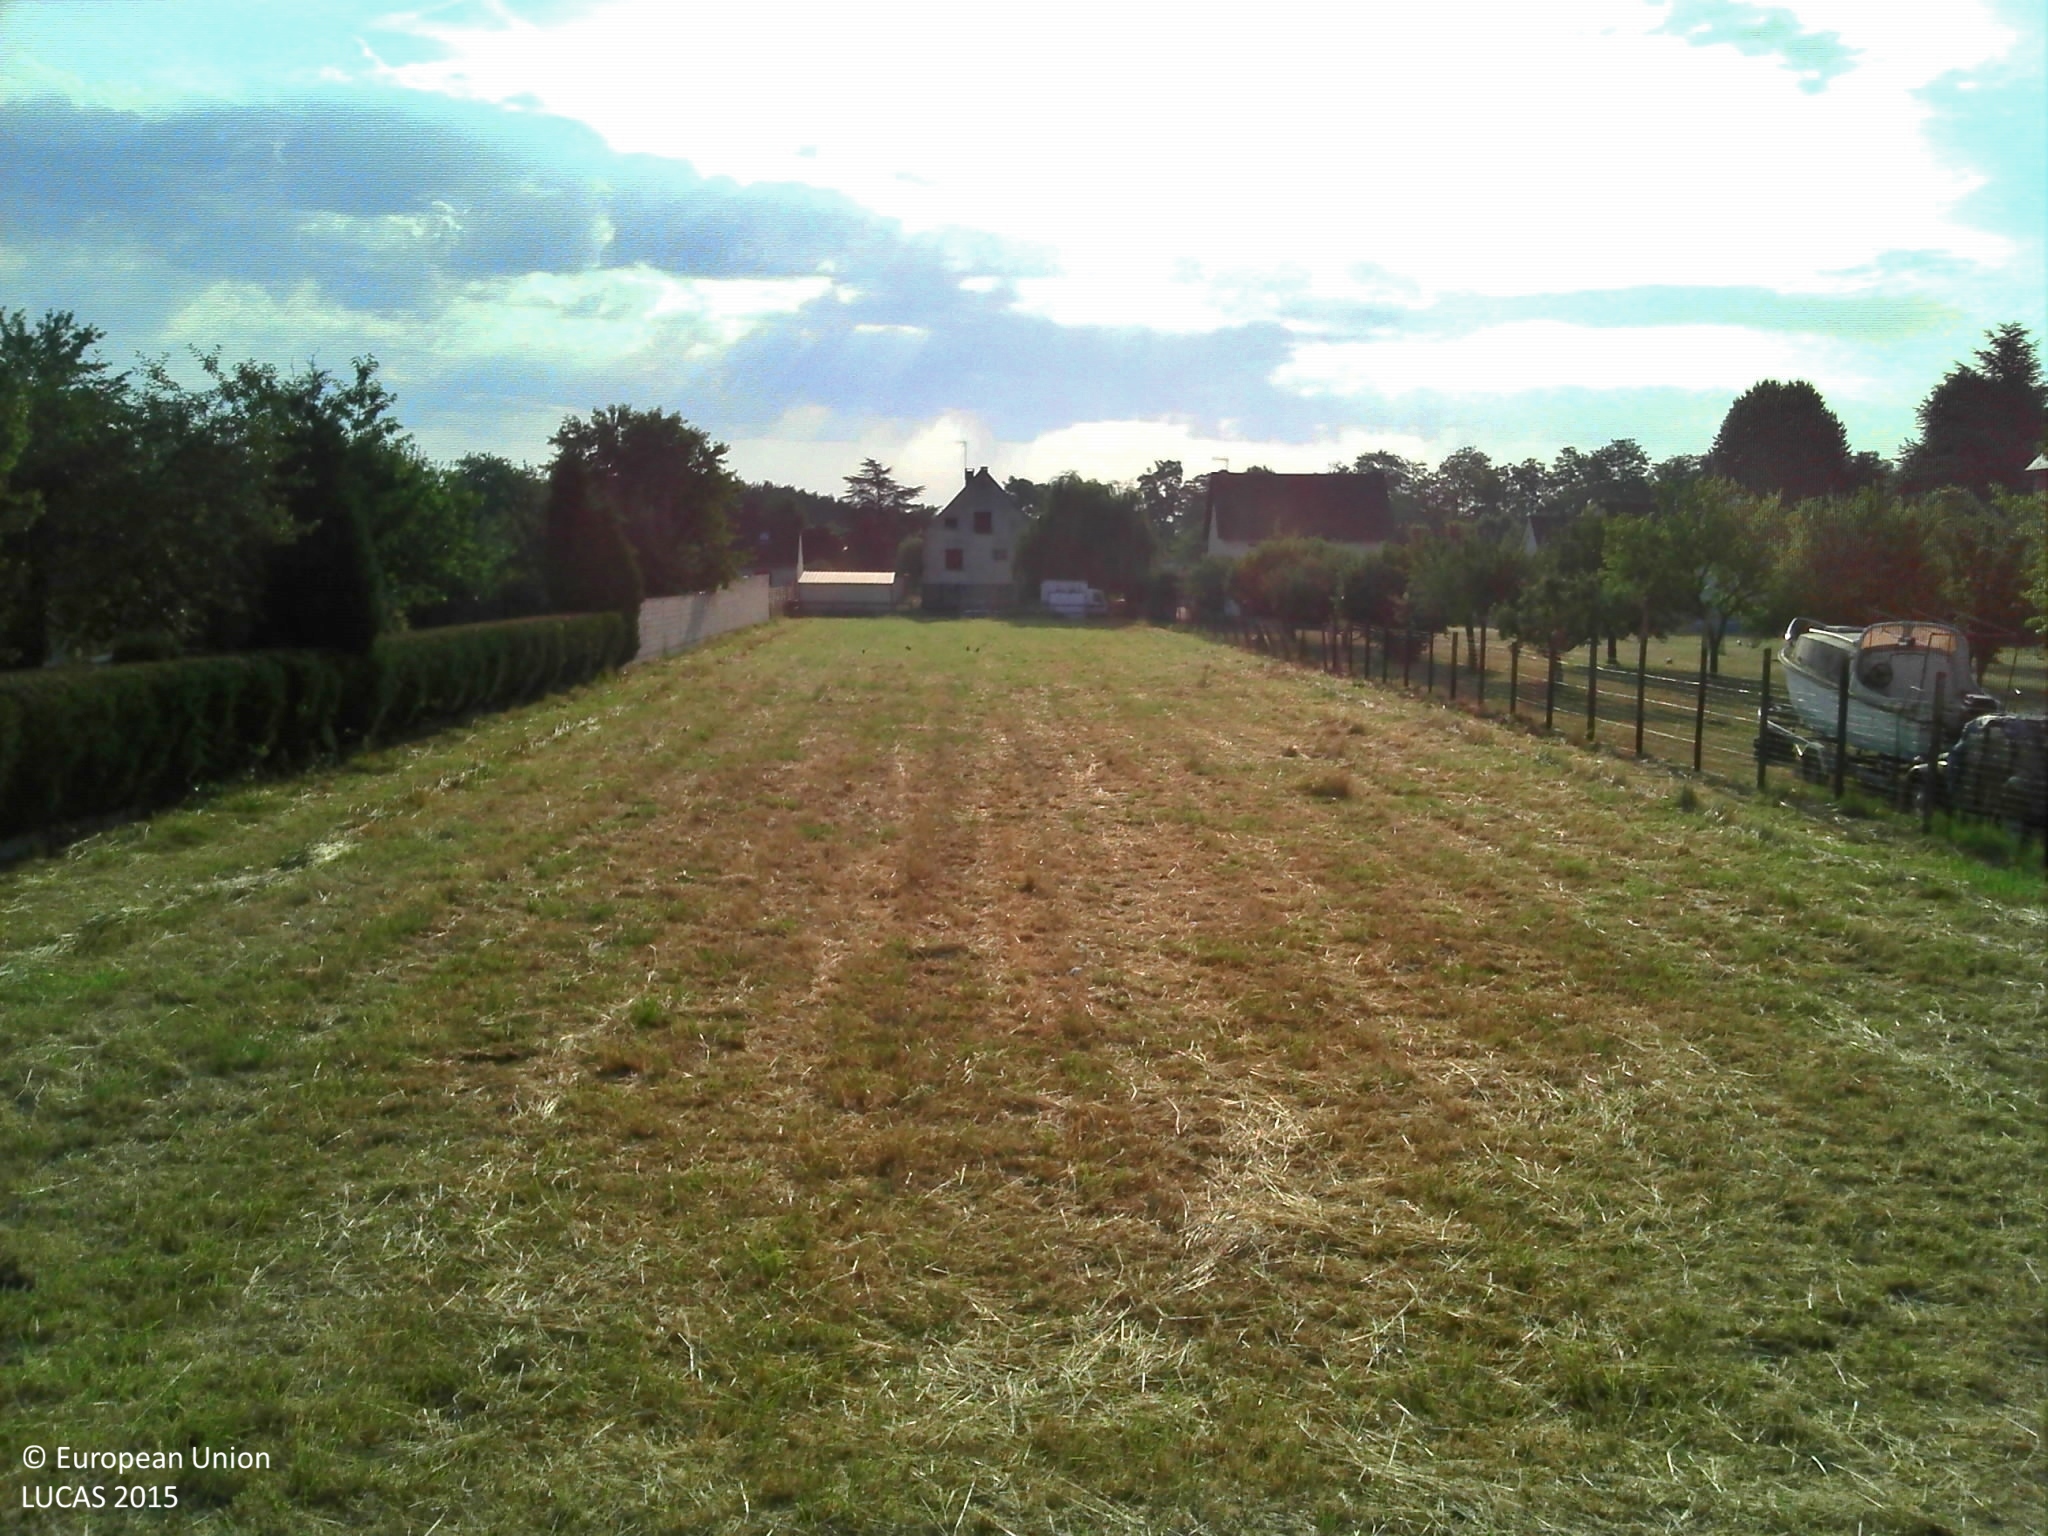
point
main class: Grassland
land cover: Grassland without tree/shrub cover
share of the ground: > 75 %
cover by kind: herbaceous plants 100 %
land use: Residential
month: July
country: FR
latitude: 49.3117
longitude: 2.6022
